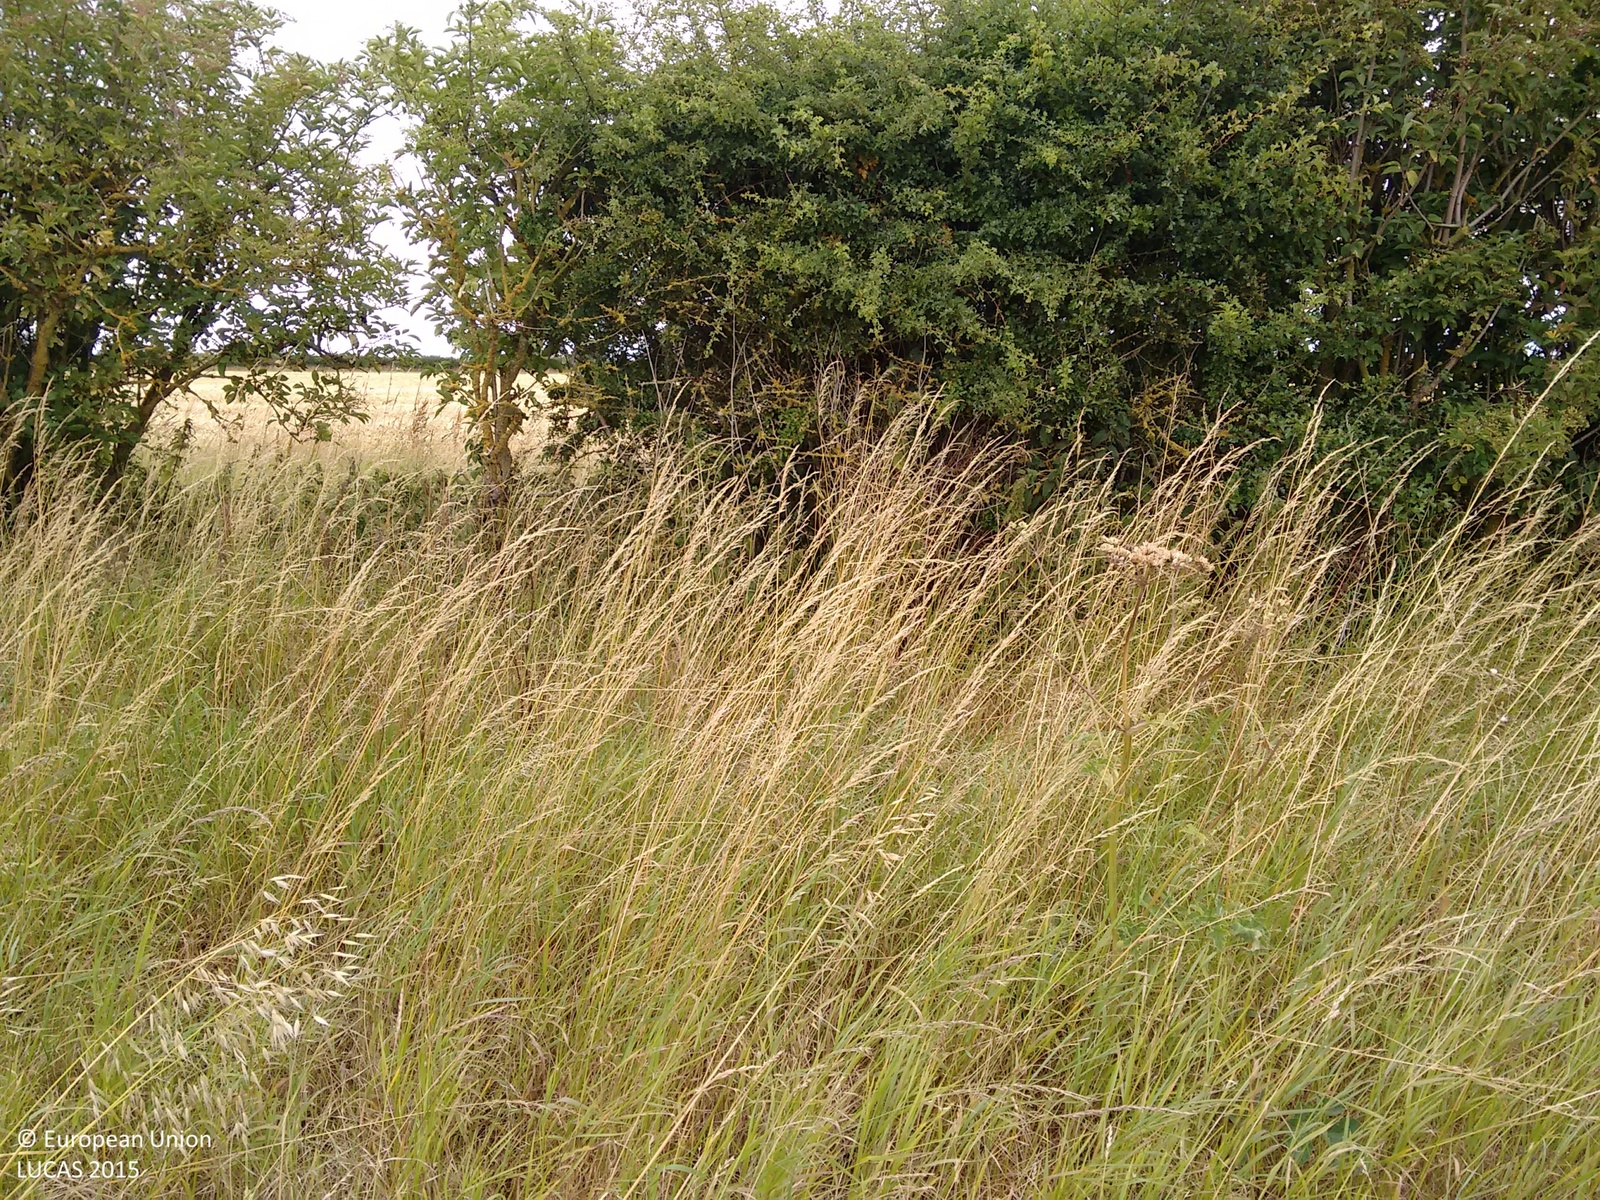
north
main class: Grassland
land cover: Grassland without tree/shrub cover
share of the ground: > 75 %
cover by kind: herbaceous plants 100 %
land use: Agriculture (excluding fallow land and kitchen gardens)
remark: Harvested field
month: July
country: GB
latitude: 52.8496
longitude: -0.7469
